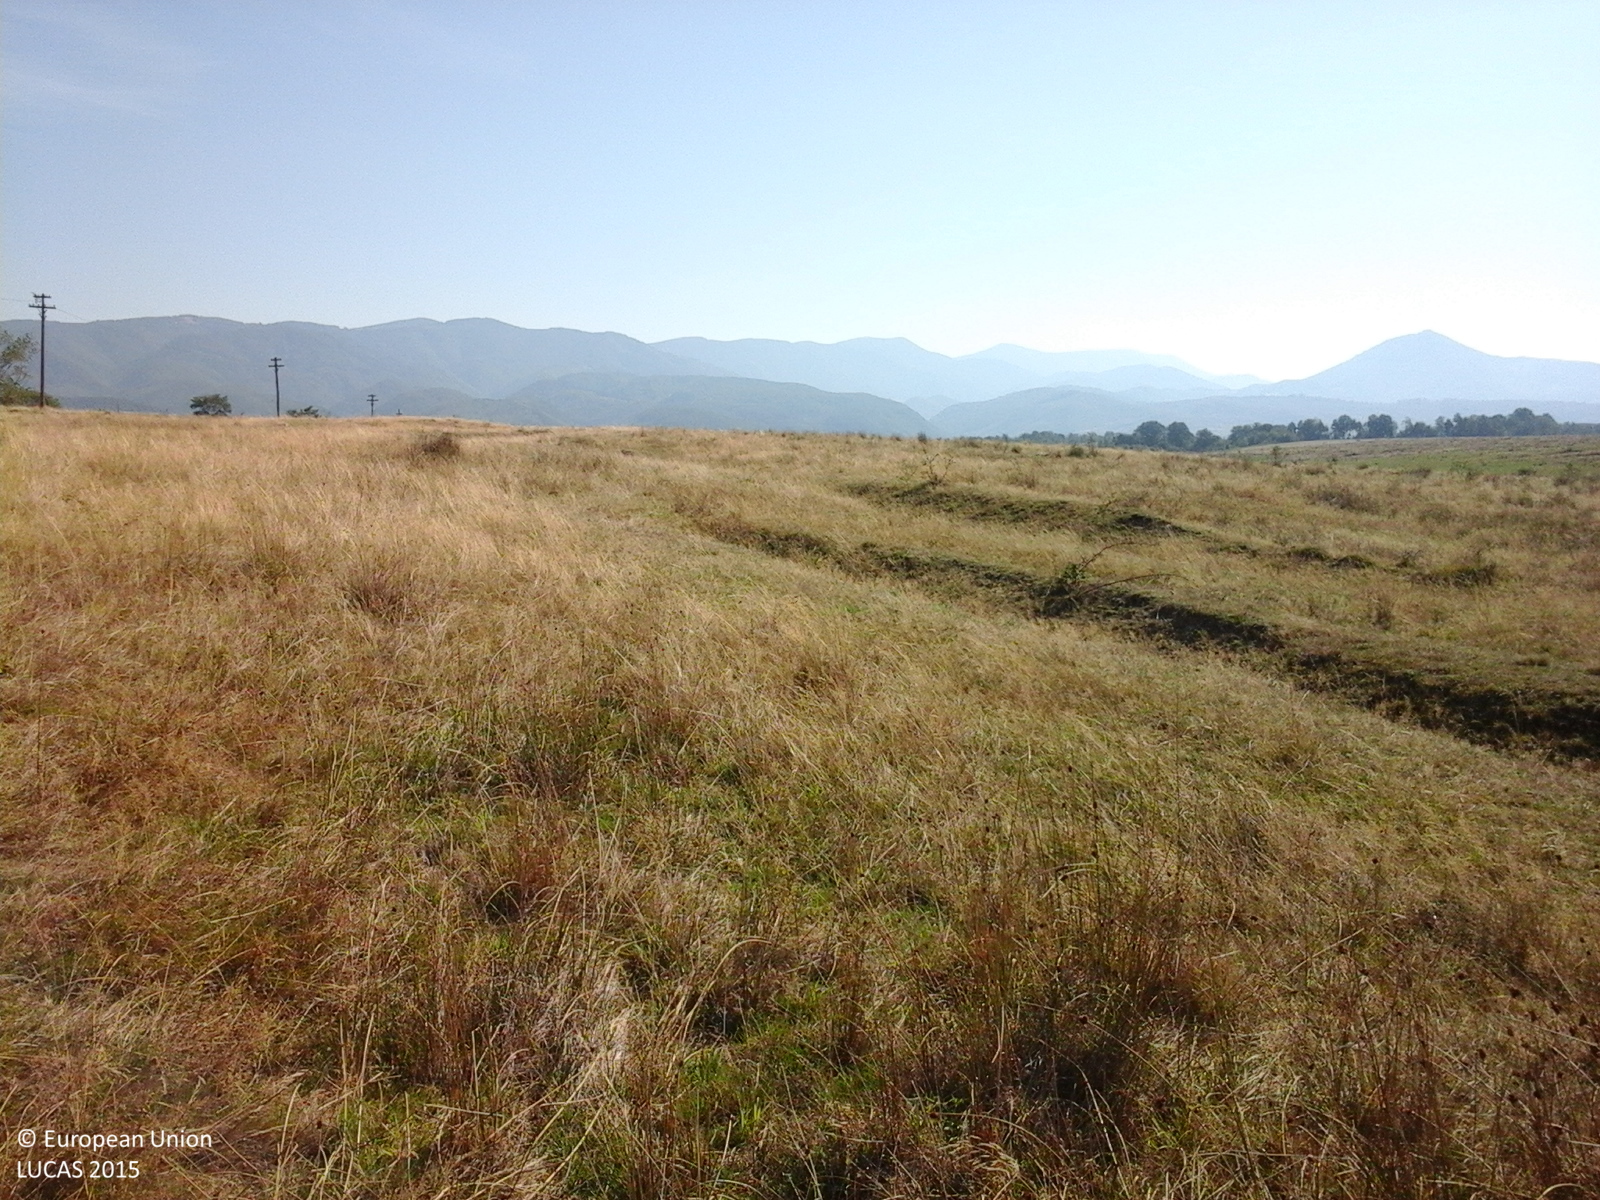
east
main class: Grassland
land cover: Grassland without tree/shrub cover
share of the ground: > 75 %
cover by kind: herbaceous plants 100 %
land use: Agriculture (excluding fallow land and kitchen gardens)
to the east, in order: Grassland without tree/shrub cover
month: September
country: RO
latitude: 46.6761
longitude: 22.4576
